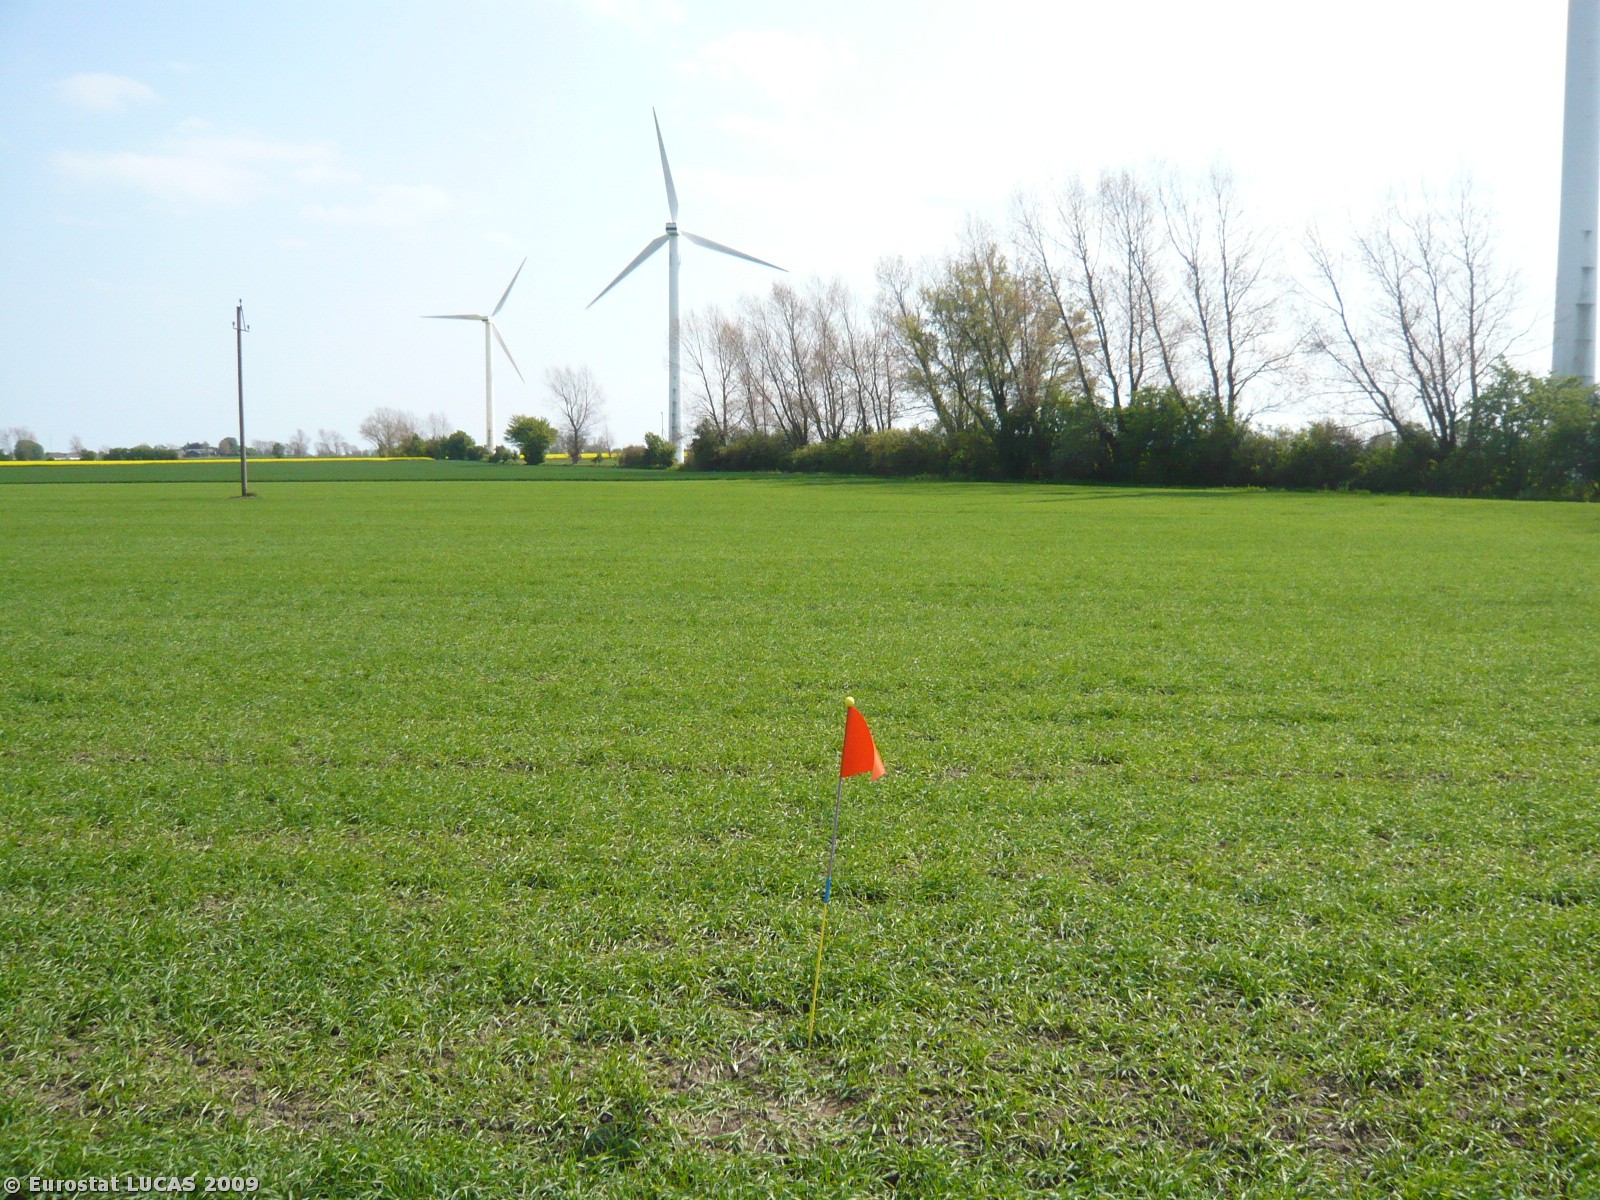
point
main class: Cropland
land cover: Barley
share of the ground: > 75 %
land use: Agriculture (excluding fallow land and kitchen gardens)
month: May
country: DK
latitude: 55.2684
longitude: 12.2805
